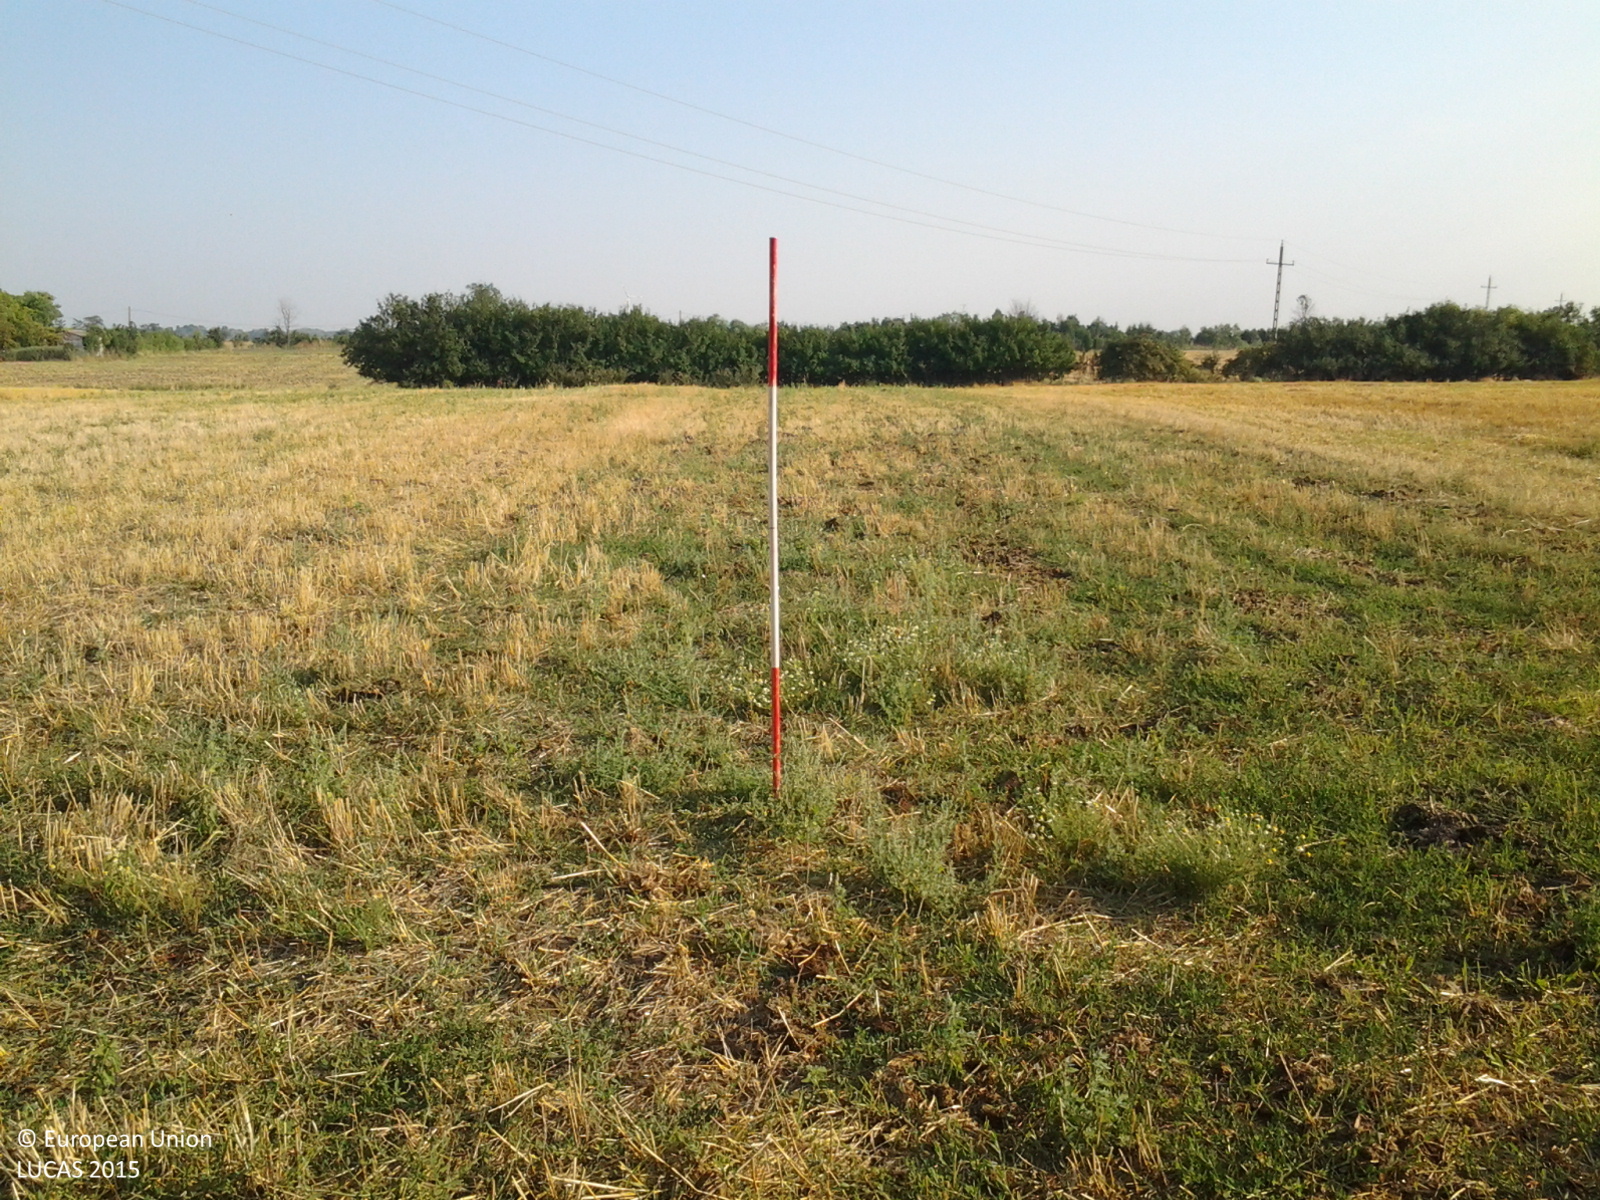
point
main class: Cropland
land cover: Common wheat
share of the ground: > 75 %
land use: Agriculture (excluding fallow land and kitchen gardens)
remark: Harvested field
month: July
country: HU
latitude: 46.9862
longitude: 20.5874
